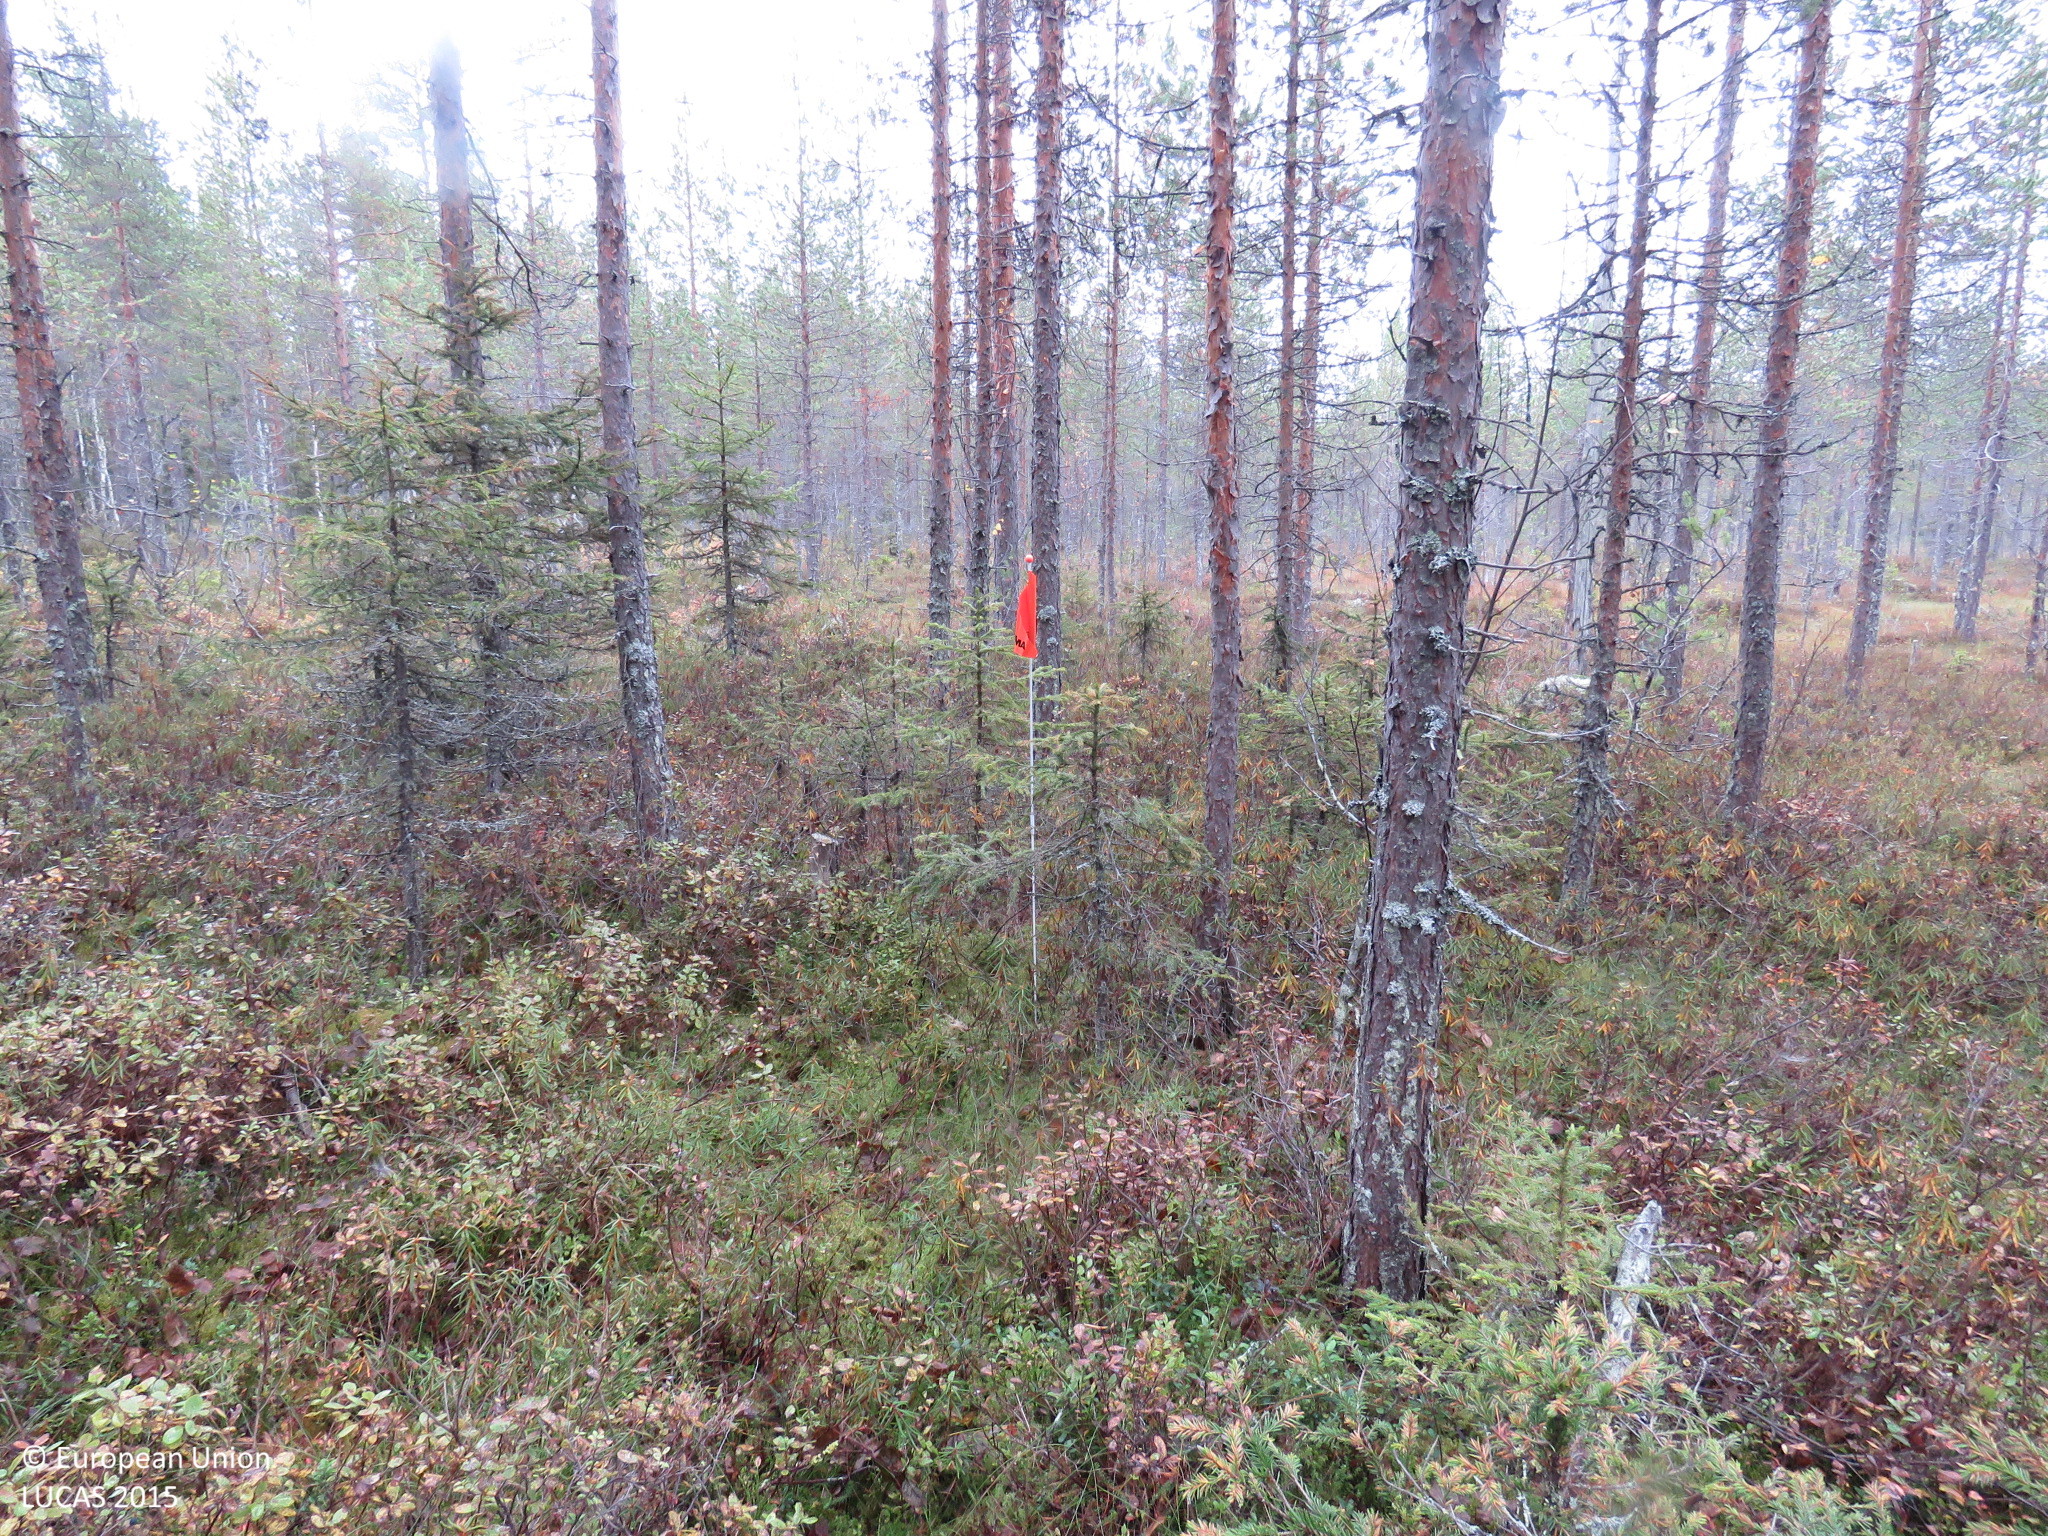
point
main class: Woodland
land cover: Other mixed woodland
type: mire and swamp forests
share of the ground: > 75 %
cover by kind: coniferous forest trees 50 %, broadleaved forest trees 25 %, shrubs 10 %, lichens and mosses 10 %, herbaceous plants 5 %
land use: Forestry
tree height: > 5 m
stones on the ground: < 10 %
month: September
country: FI
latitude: 64.8395
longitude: 27.0529
